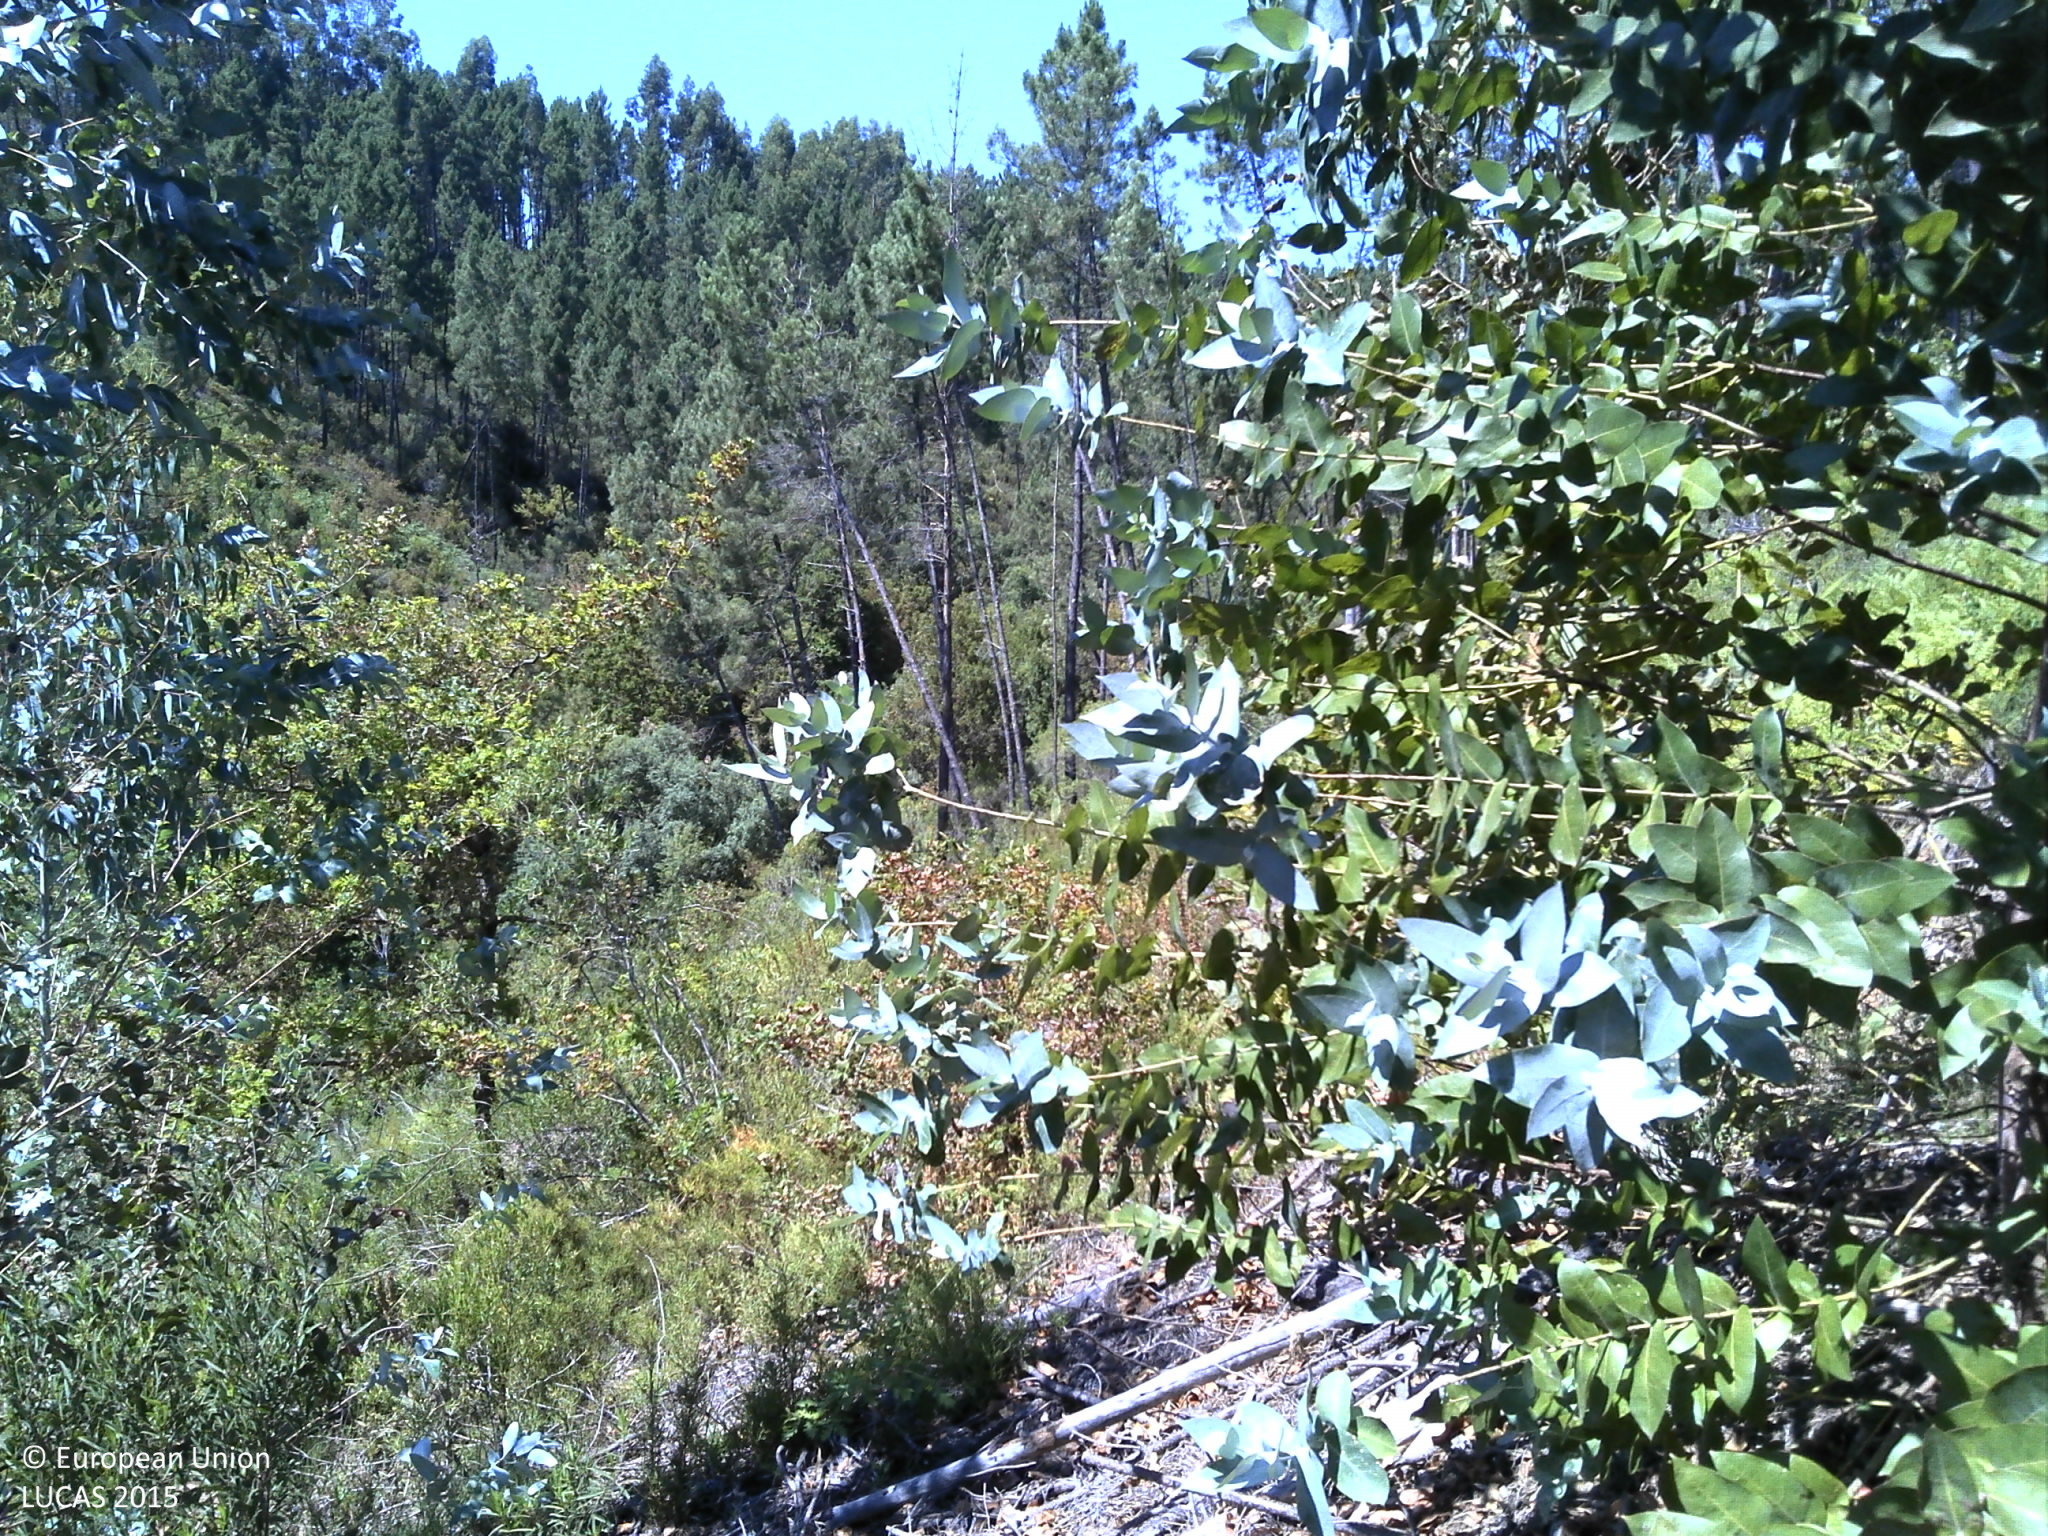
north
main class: Woodland
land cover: Broadleaved woodland
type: exotic forest
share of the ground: 10 - 25 %
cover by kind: unconsolidated bare surface 55 %, shrubs 30 %, broadleaved forest trees 15 %
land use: Forestry
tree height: > 5 m
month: July
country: PT
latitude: 39.9223
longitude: -8.1713
